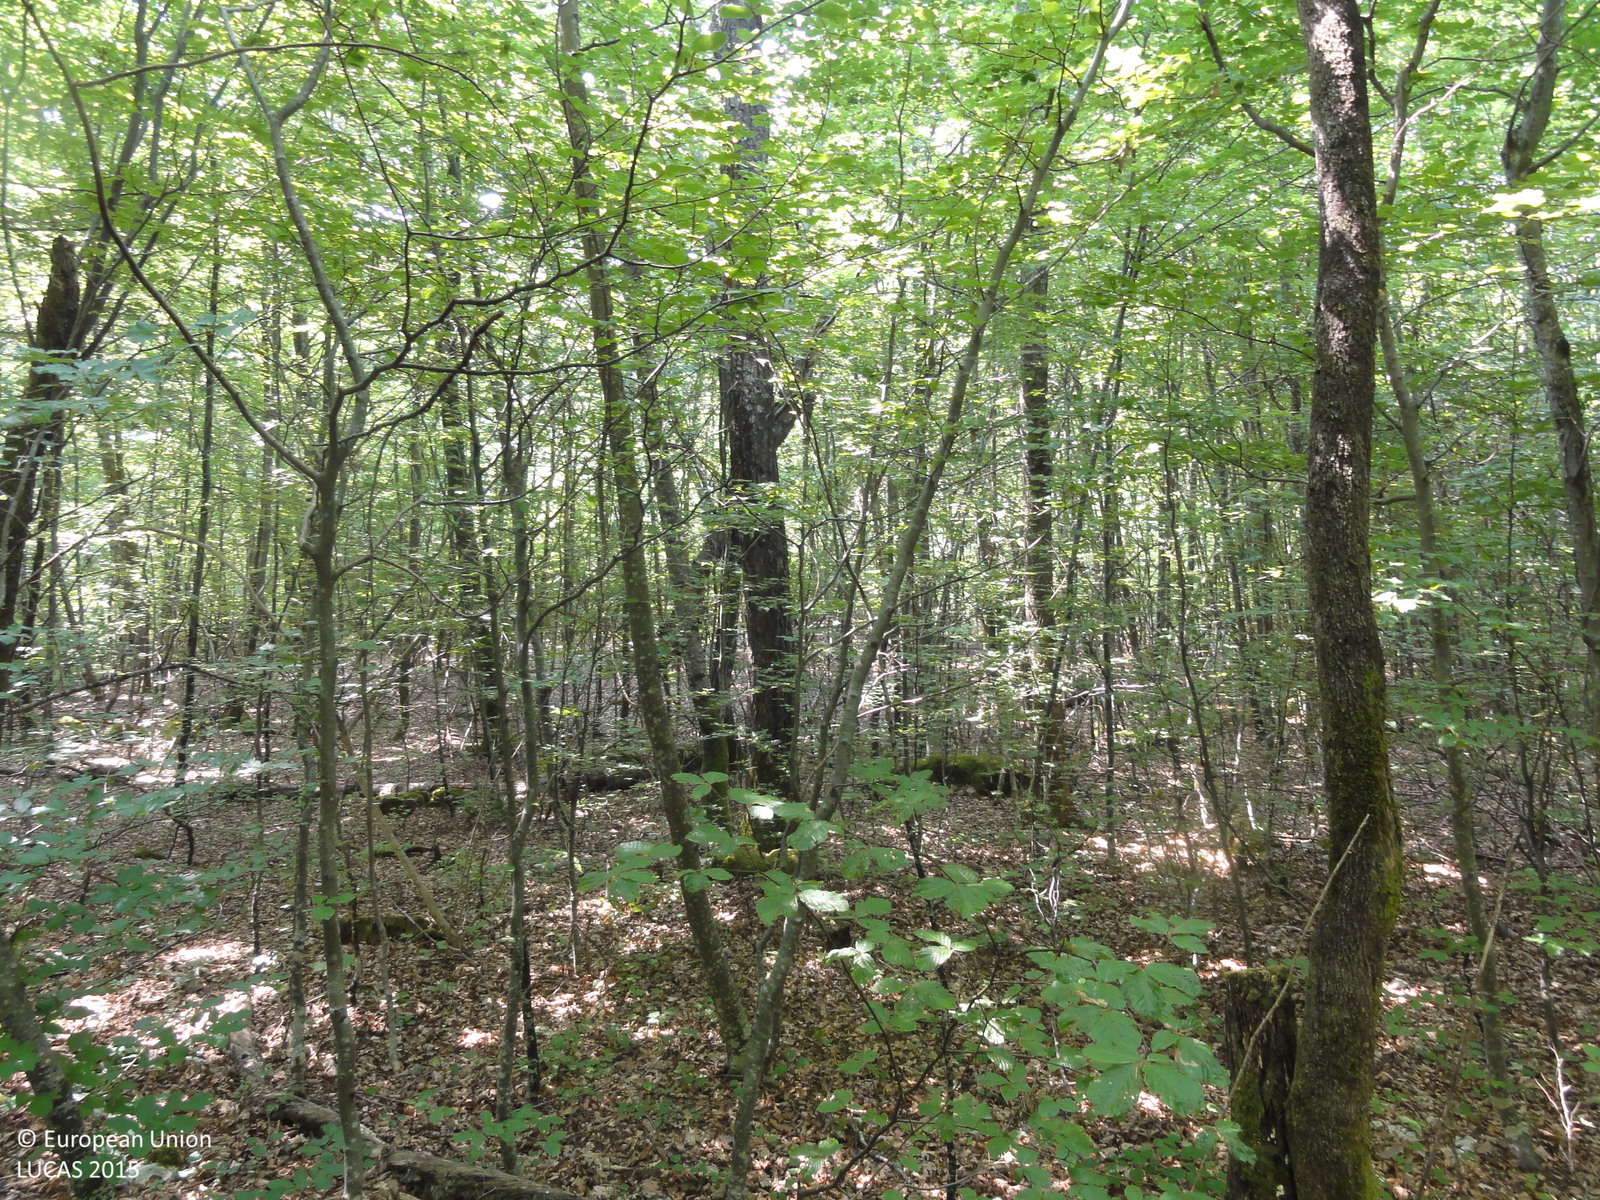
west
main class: Woodland
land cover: Broadleaved woodland
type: beech forest
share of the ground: > 75 %
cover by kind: broadleaved forest trees 100 %
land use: Forestry
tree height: > 5 m
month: July
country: SI
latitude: 45.8454
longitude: 14.8250
